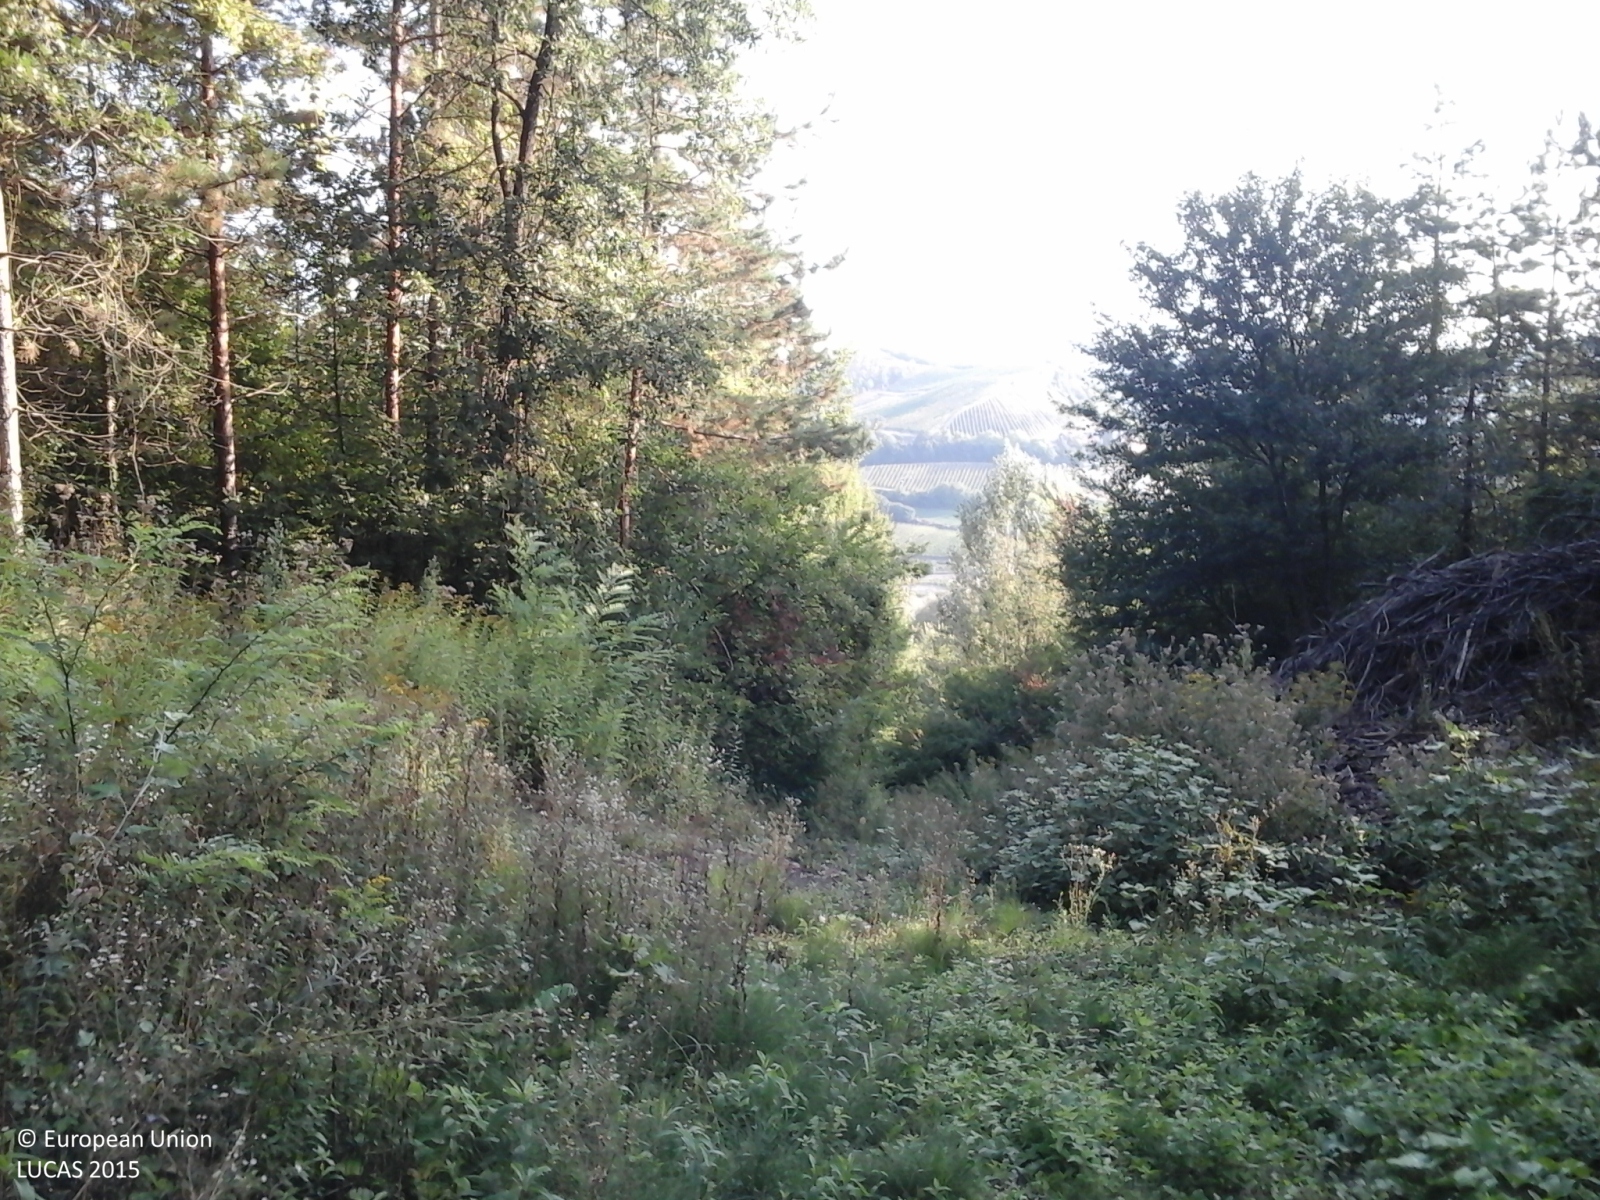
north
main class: Woodland
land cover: Broadleaved woodland
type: thermophilous deciduous forest
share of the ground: > 75 %
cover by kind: broadleaved forest trees 80 %, shrubs 20 %
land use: Forestry
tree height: > 5 m
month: August
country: IT
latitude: 44.9237
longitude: 9.1023
